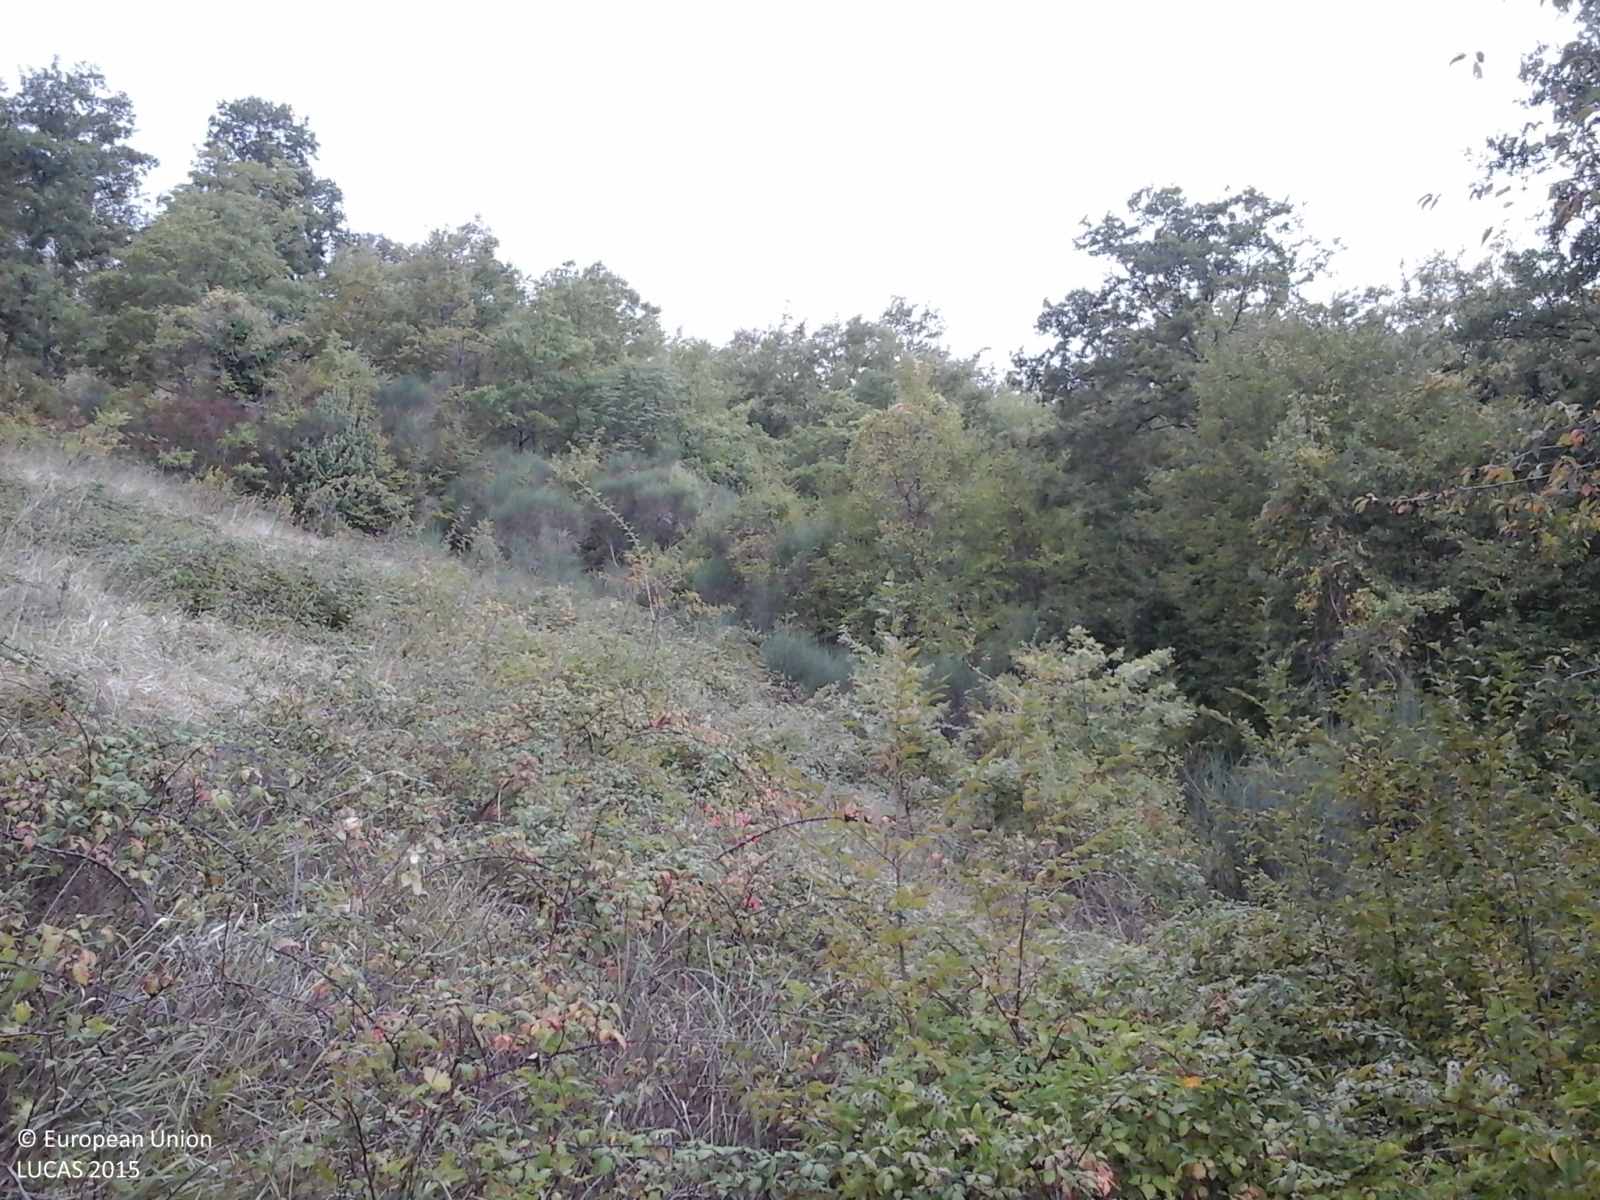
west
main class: Woodland
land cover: Broadleaved woodland
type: thermophilous deciduous forest
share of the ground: > 75 %
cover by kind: broadleaved forest trees 90 %, shrubs 10 %
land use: Forestry
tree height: > 5 m
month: October
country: IT
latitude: 43.1996
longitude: 12.5649
